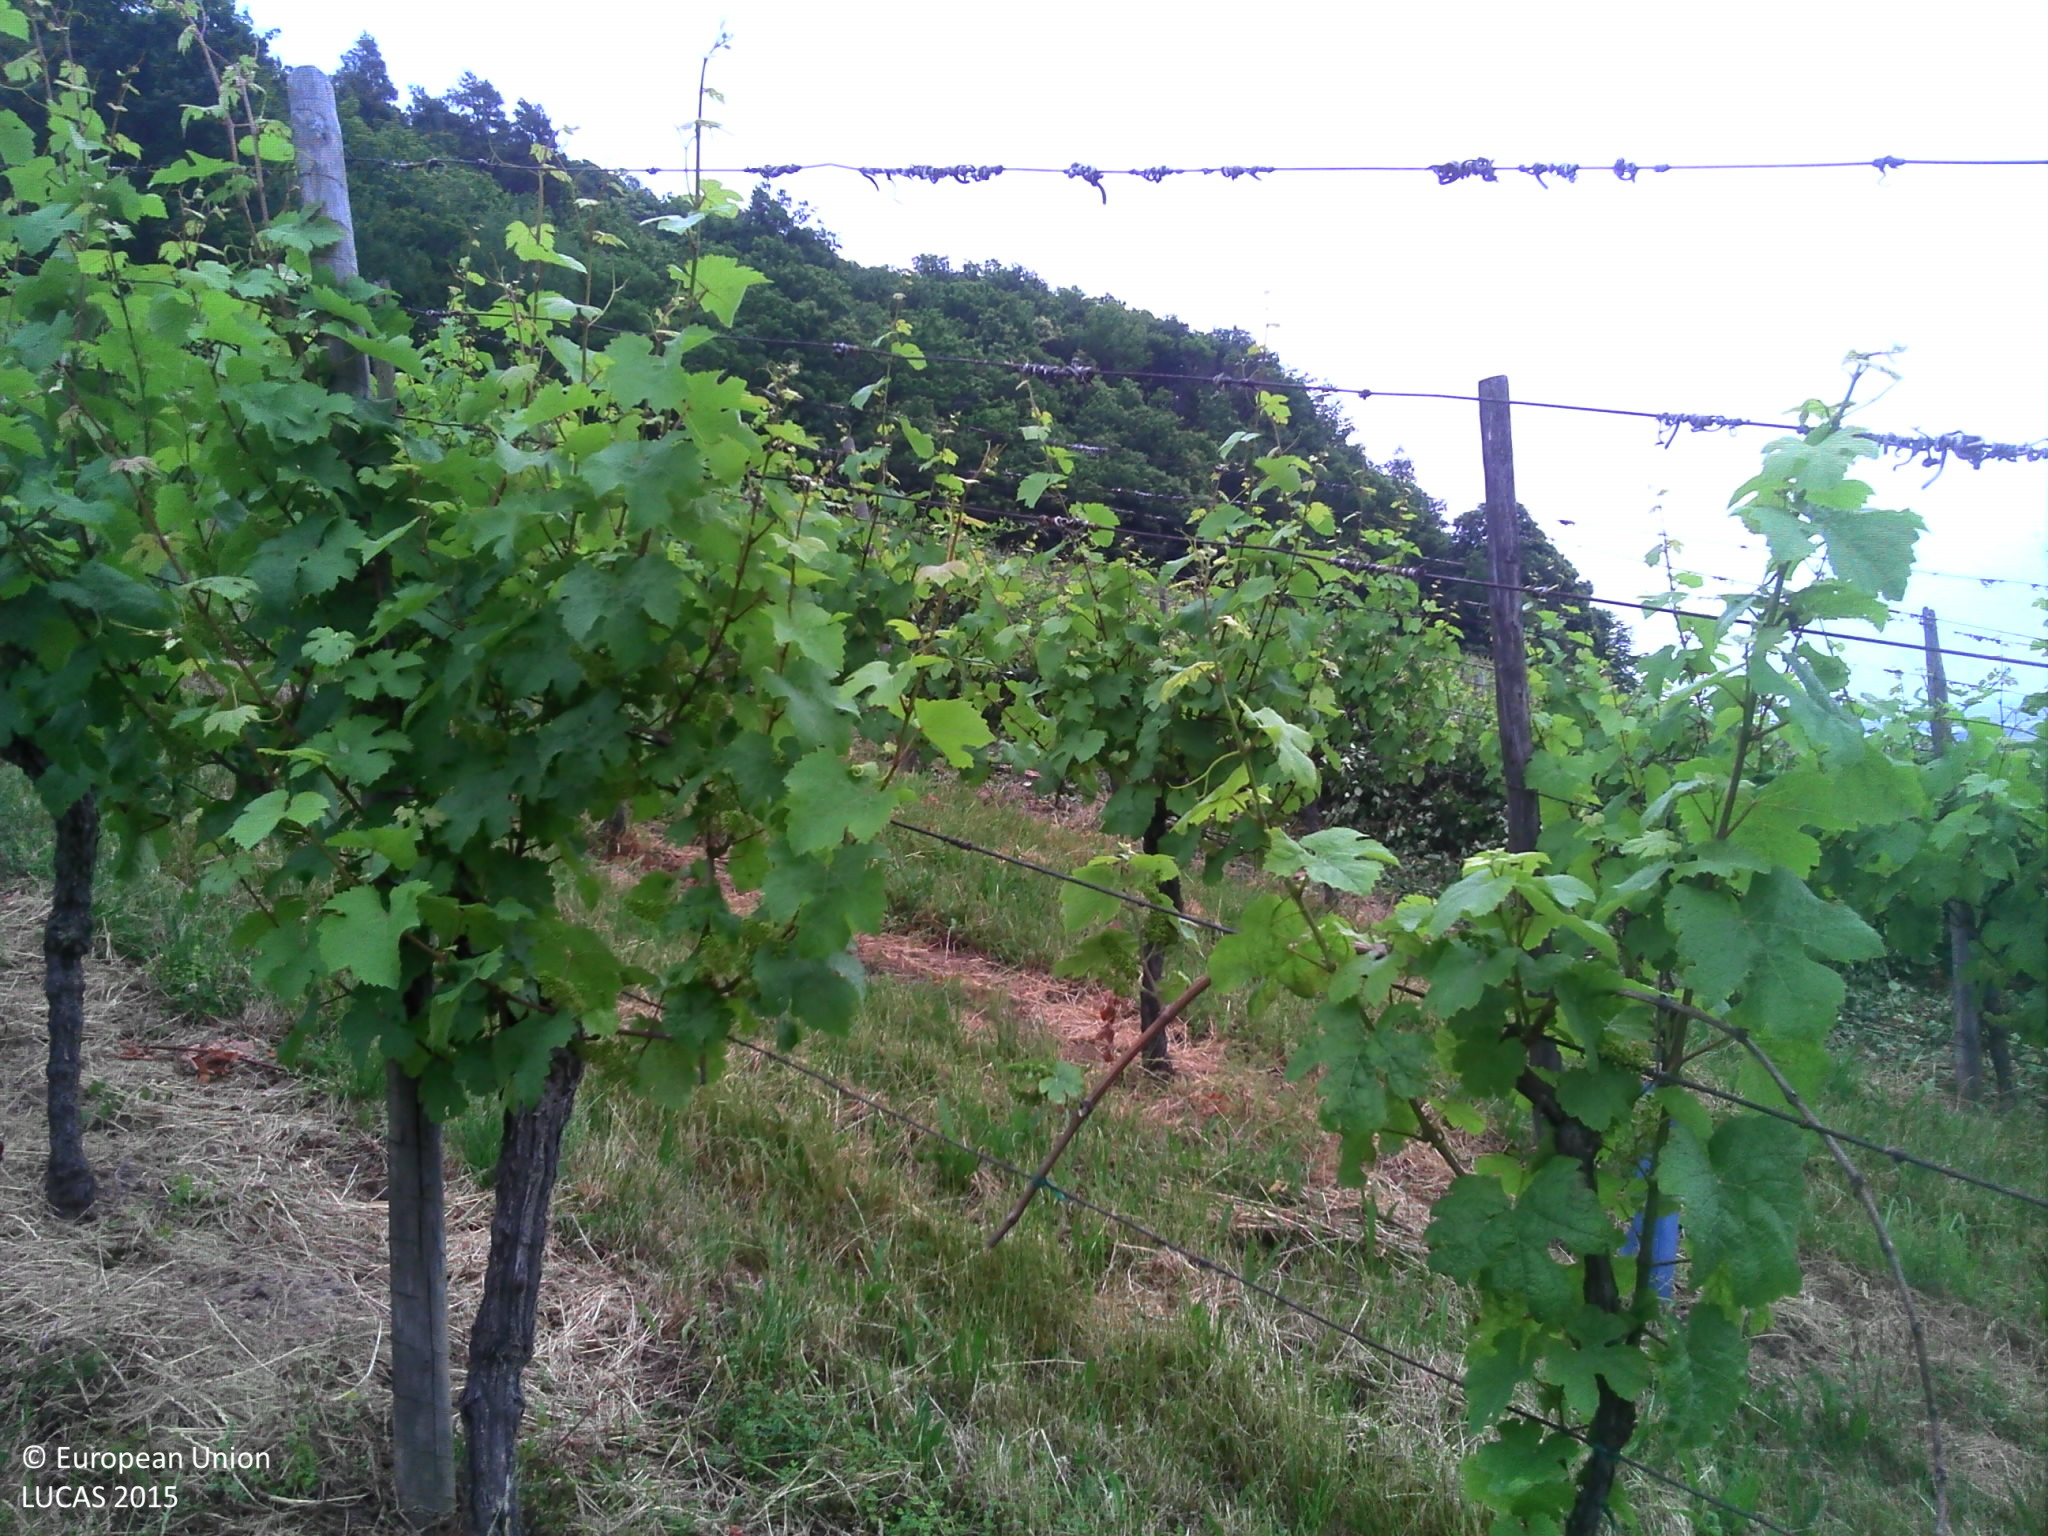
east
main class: Cropland
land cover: Vineyards
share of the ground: 25 - 50 %
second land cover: Grassland without tree/shrub cover
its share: 50 - 75 %
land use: Agriculture (excluding fallow land and kitchen gardens)
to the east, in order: Vineyards; Grassland without tree/shrub cover; Managed hedges; Tracks; Vineyards; Grass margins; Paved roads, cycling and walking lanes; Grass margins; Broadleaved woodland; Dry stone walls; Broadleaved woodland; Tracks; Grassland with sparse tree/shrub cover
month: June
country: FR
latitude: 48.3914
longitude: 7.4215
